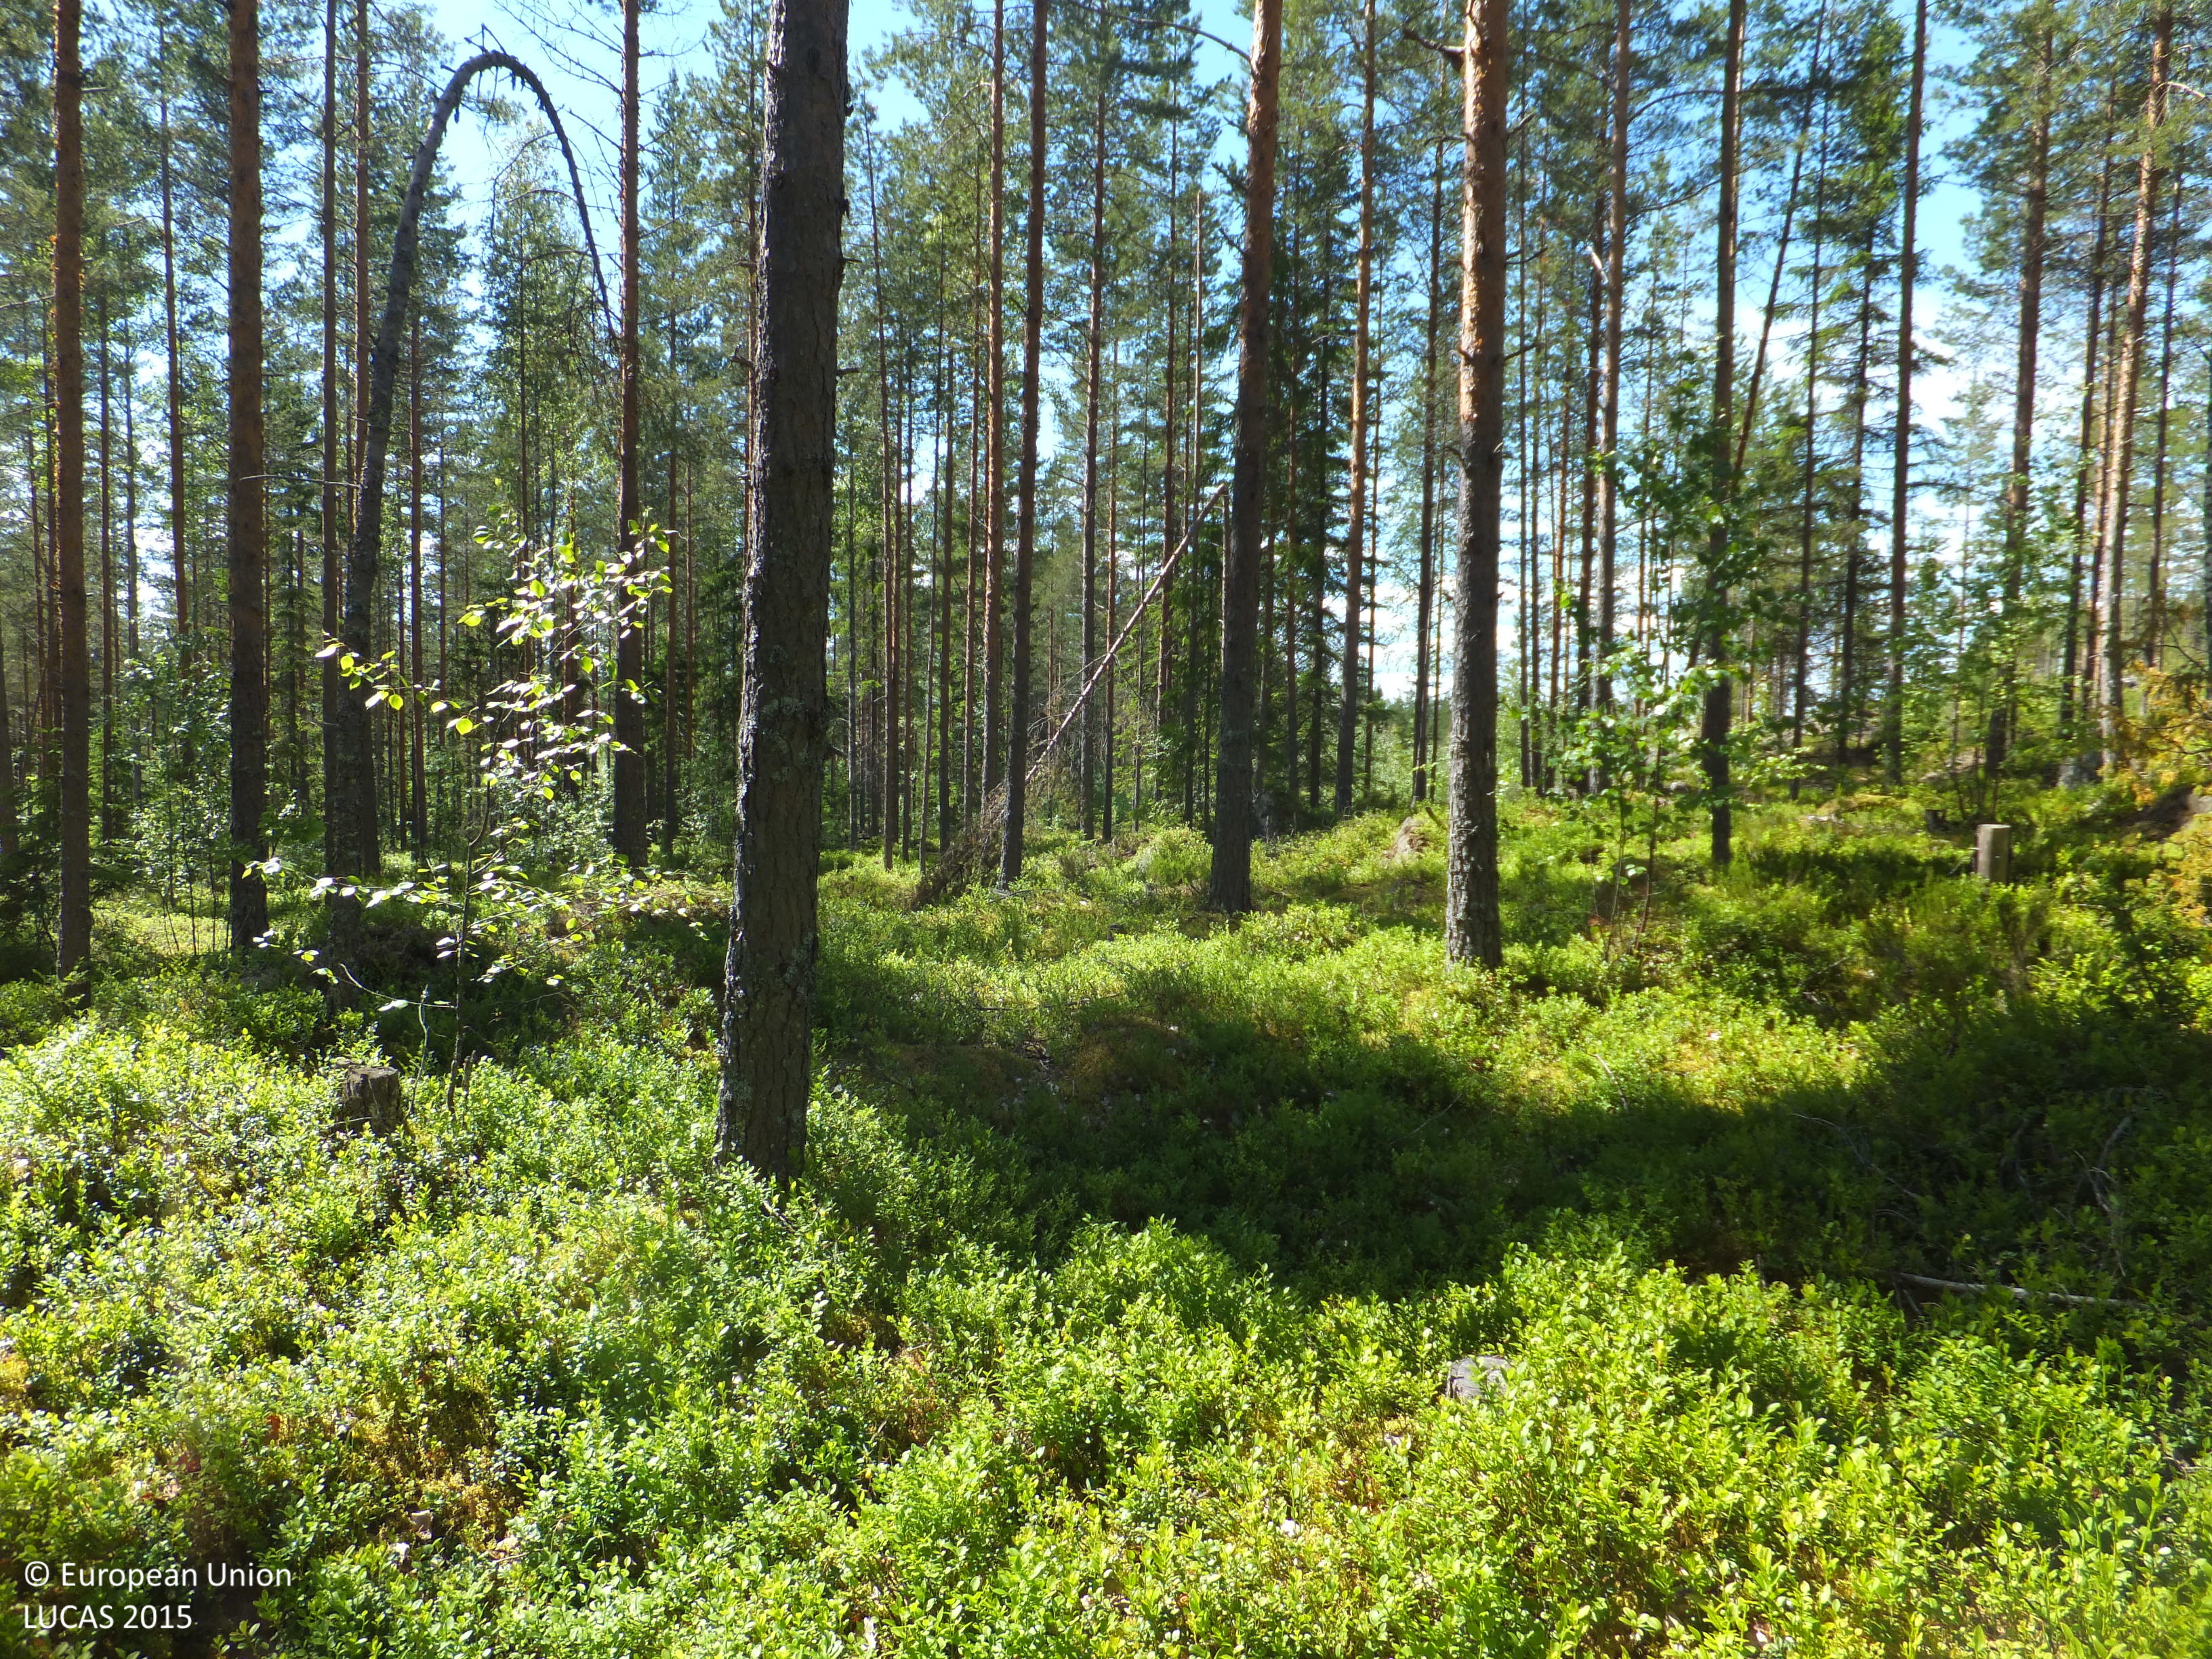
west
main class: Woodland
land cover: Pine dominated mixed woodland
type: boreal forest
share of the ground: 50 - 75 %
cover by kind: coniferous forest trees 40 %, shrubs 25 %, broadleaved forest trees 15 %, lichens and mosses 15 %, consolidated bare surface 5 %
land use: Forestry
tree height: > 5 m
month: July
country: FI
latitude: 63.0439
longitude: 23.9349
